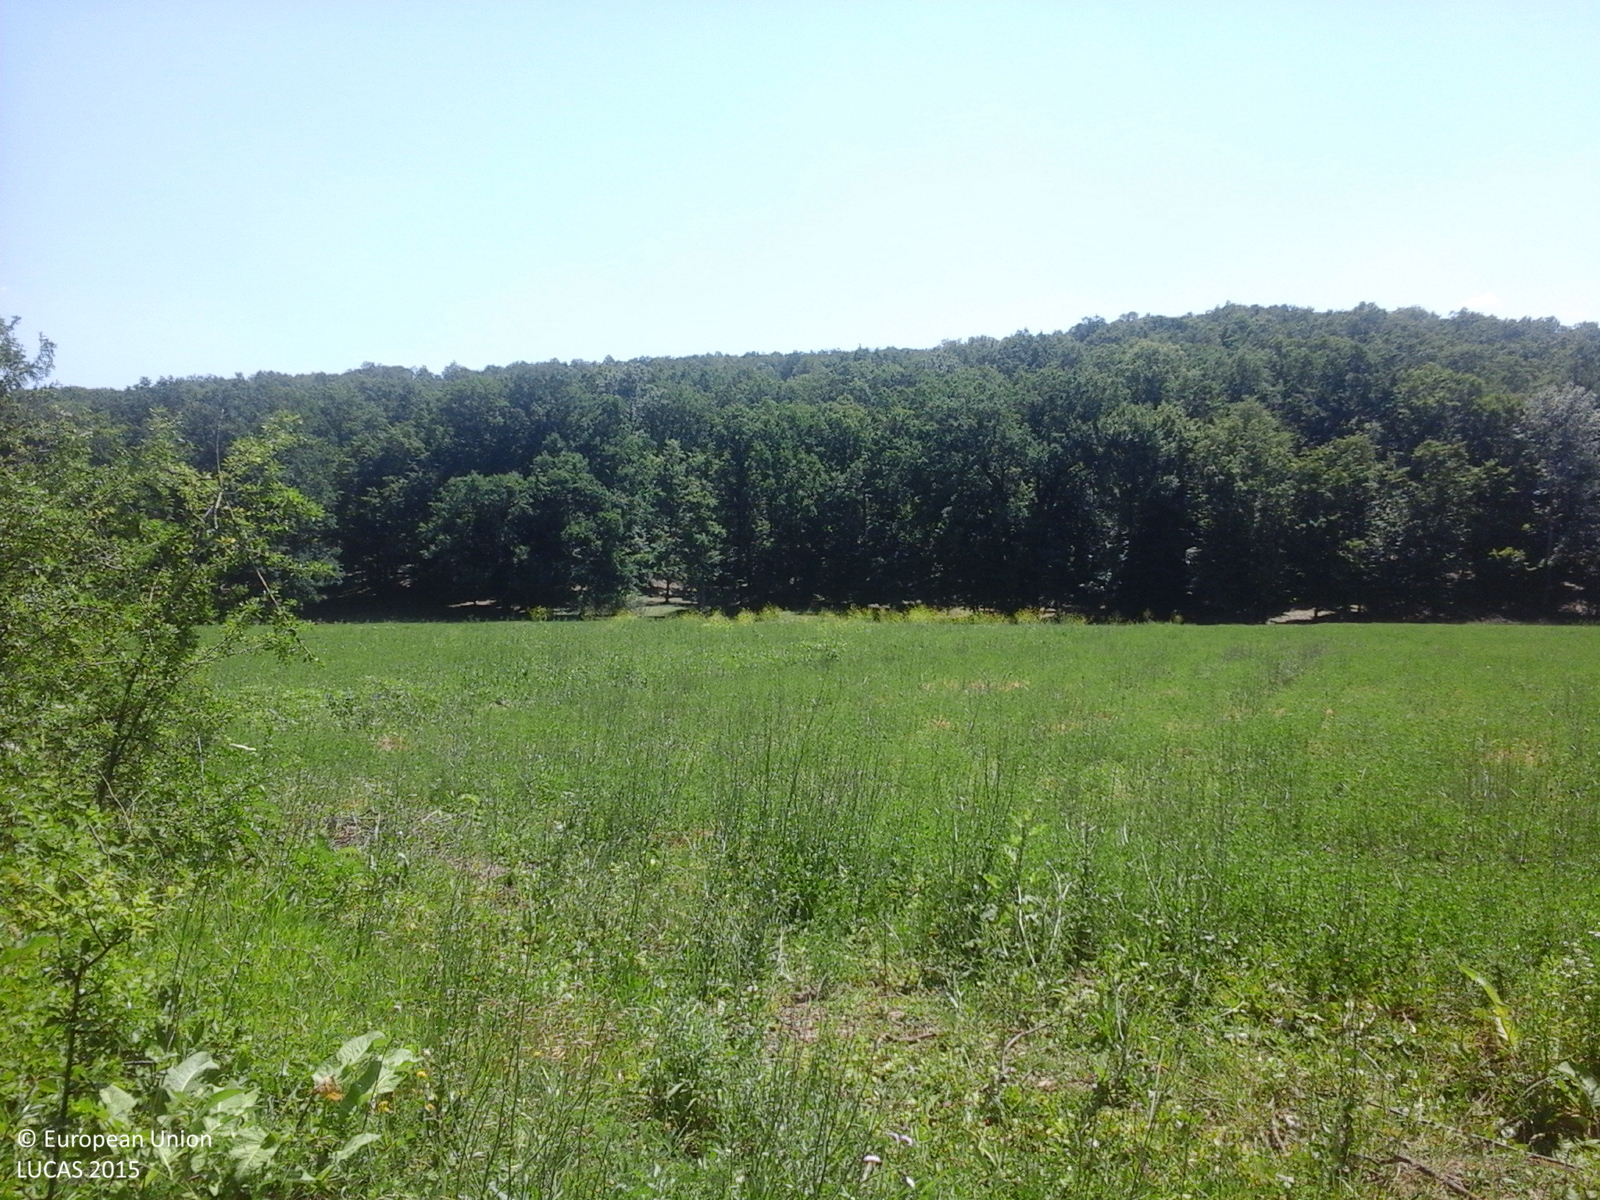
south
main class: Woodland
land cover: Broadleaved woodland
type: mesophytic deciduous forest
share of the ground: > 75 %
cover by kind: broadleaved forest trees 100 %
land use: Forestry
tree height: > 5 m
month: June
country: RO
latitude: 46.9941
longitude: 27.2678
